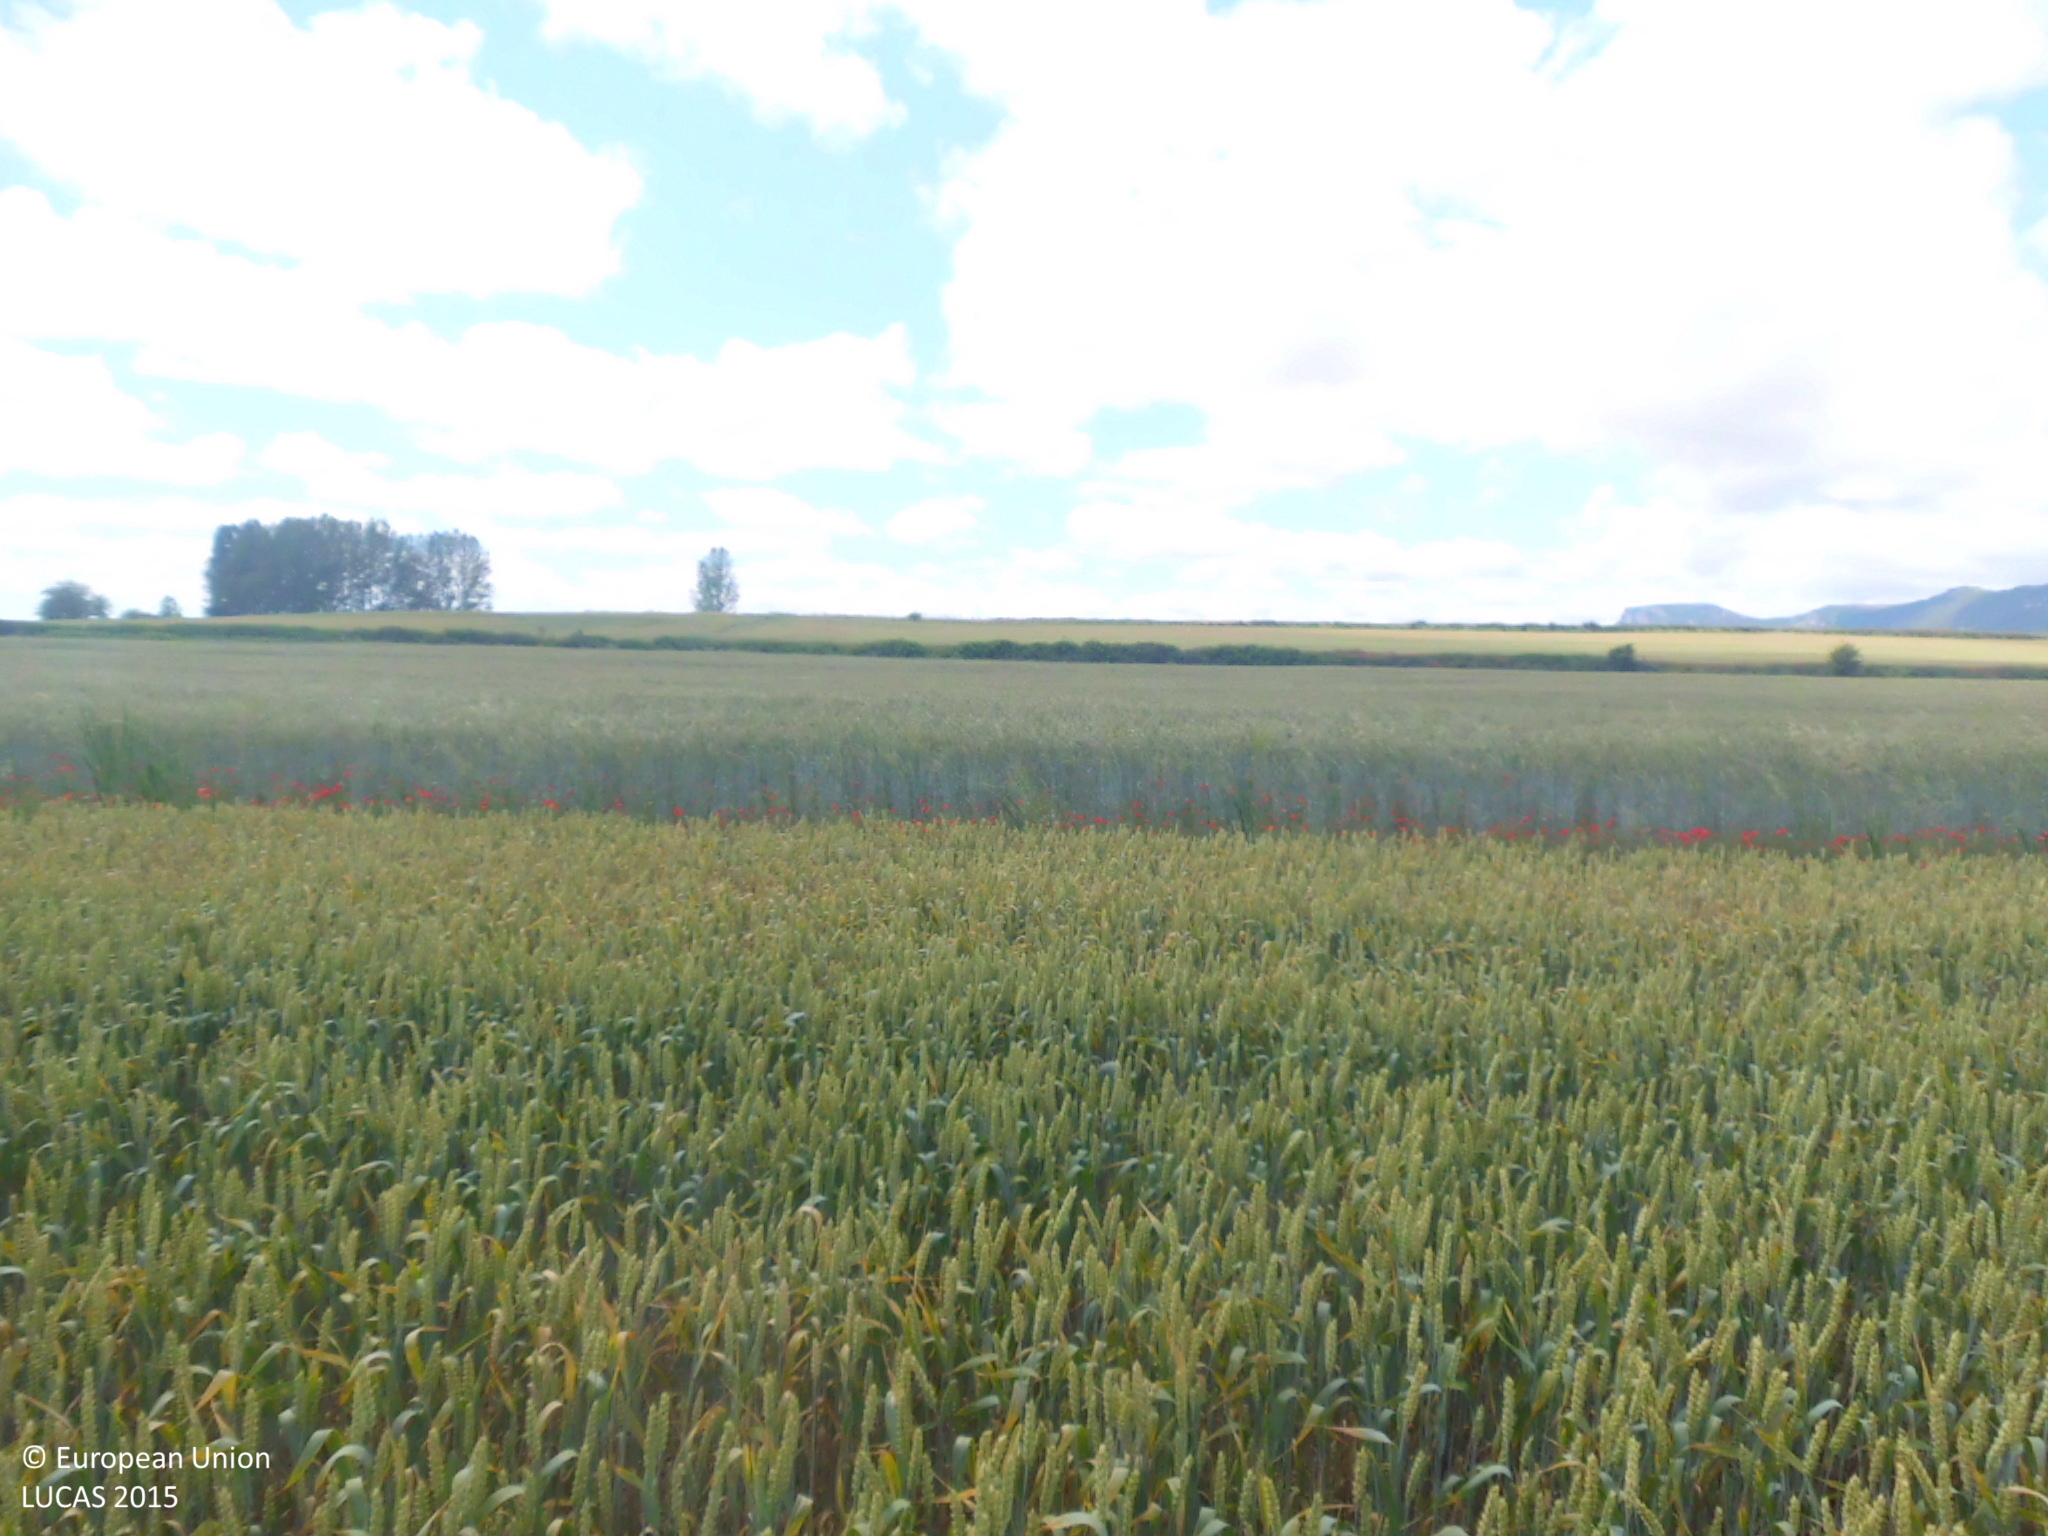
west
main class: Cropland
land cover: Common wheat
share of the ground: > 75 %
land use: Agriculture (excluding fallow land and kitchen gardens)
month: June
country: ES
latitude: 42.6508
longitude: -3.2925
